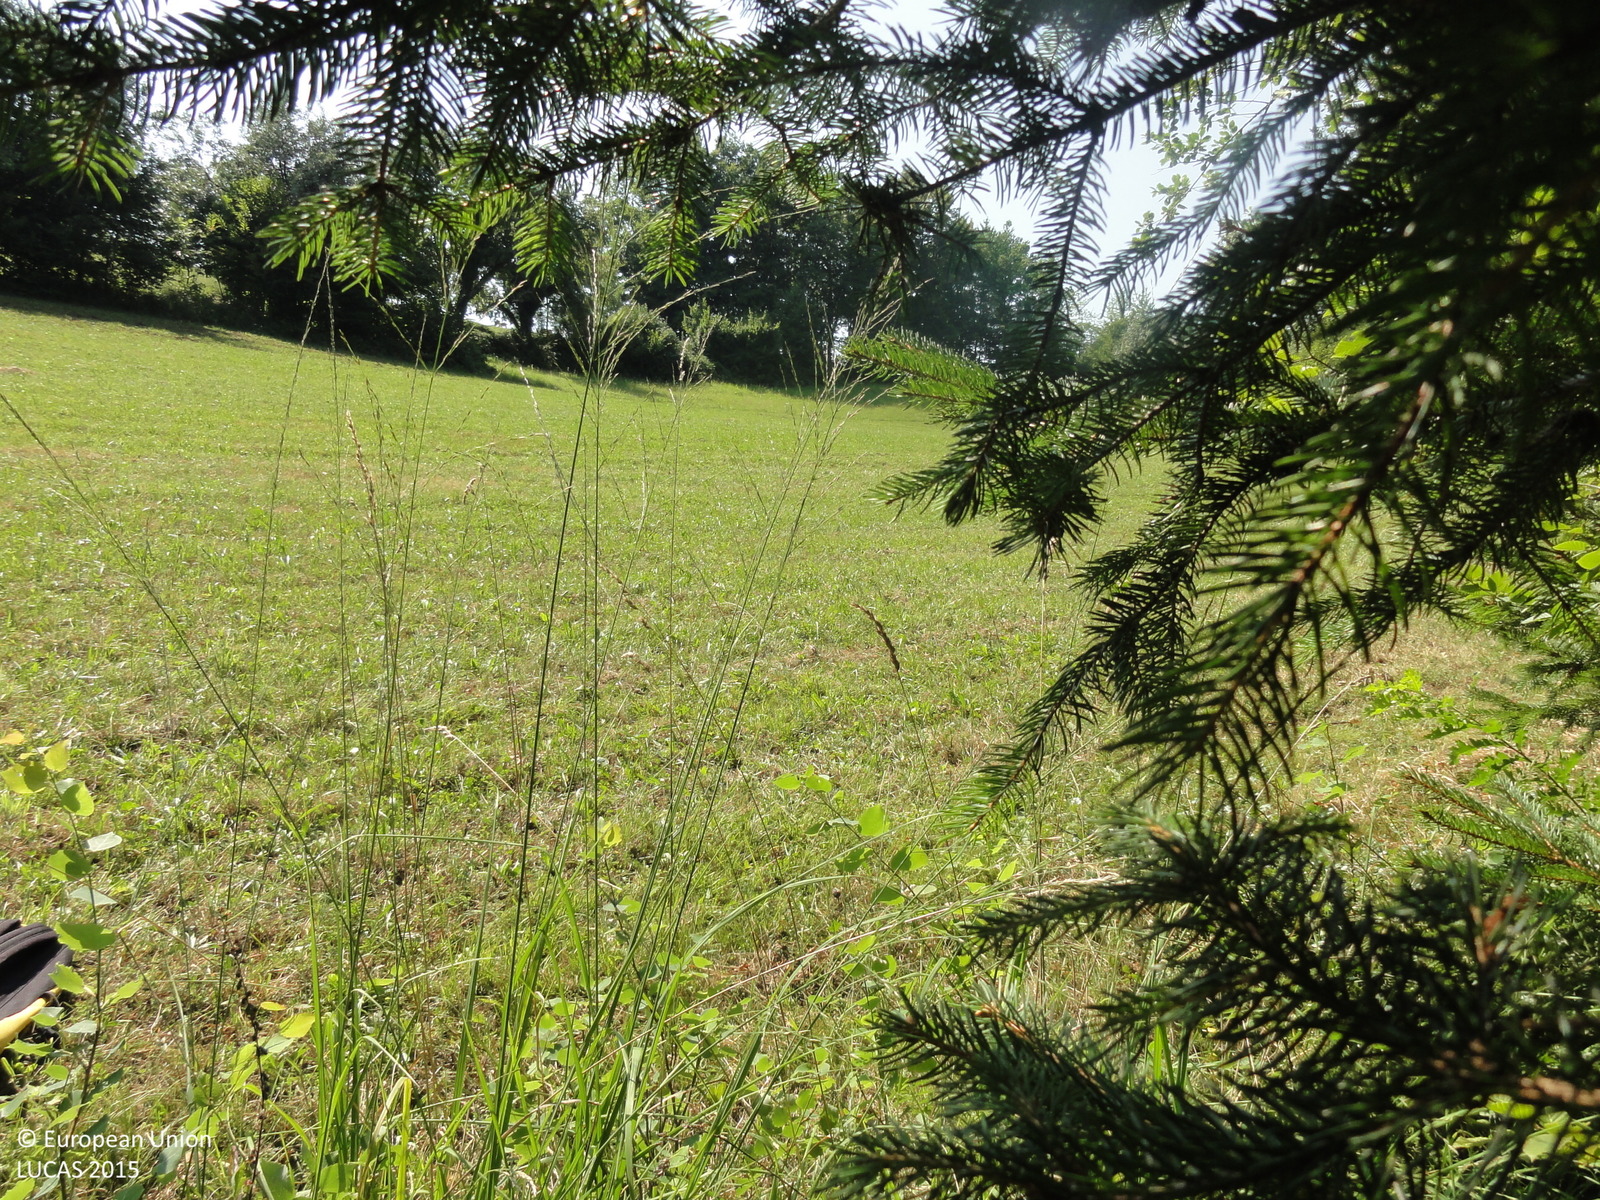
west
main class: Woodland
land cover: Spruce dominated mixed woodland
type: mesophytic deciduous forest
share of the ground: > 75 %
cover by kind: broadleaved forest trees 50 %, coniferous forest trees 40 %, shrubs 10 %
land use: Forestry
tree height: > 5 m
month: August
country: SI
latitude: 46.0155
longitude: 15.0471
